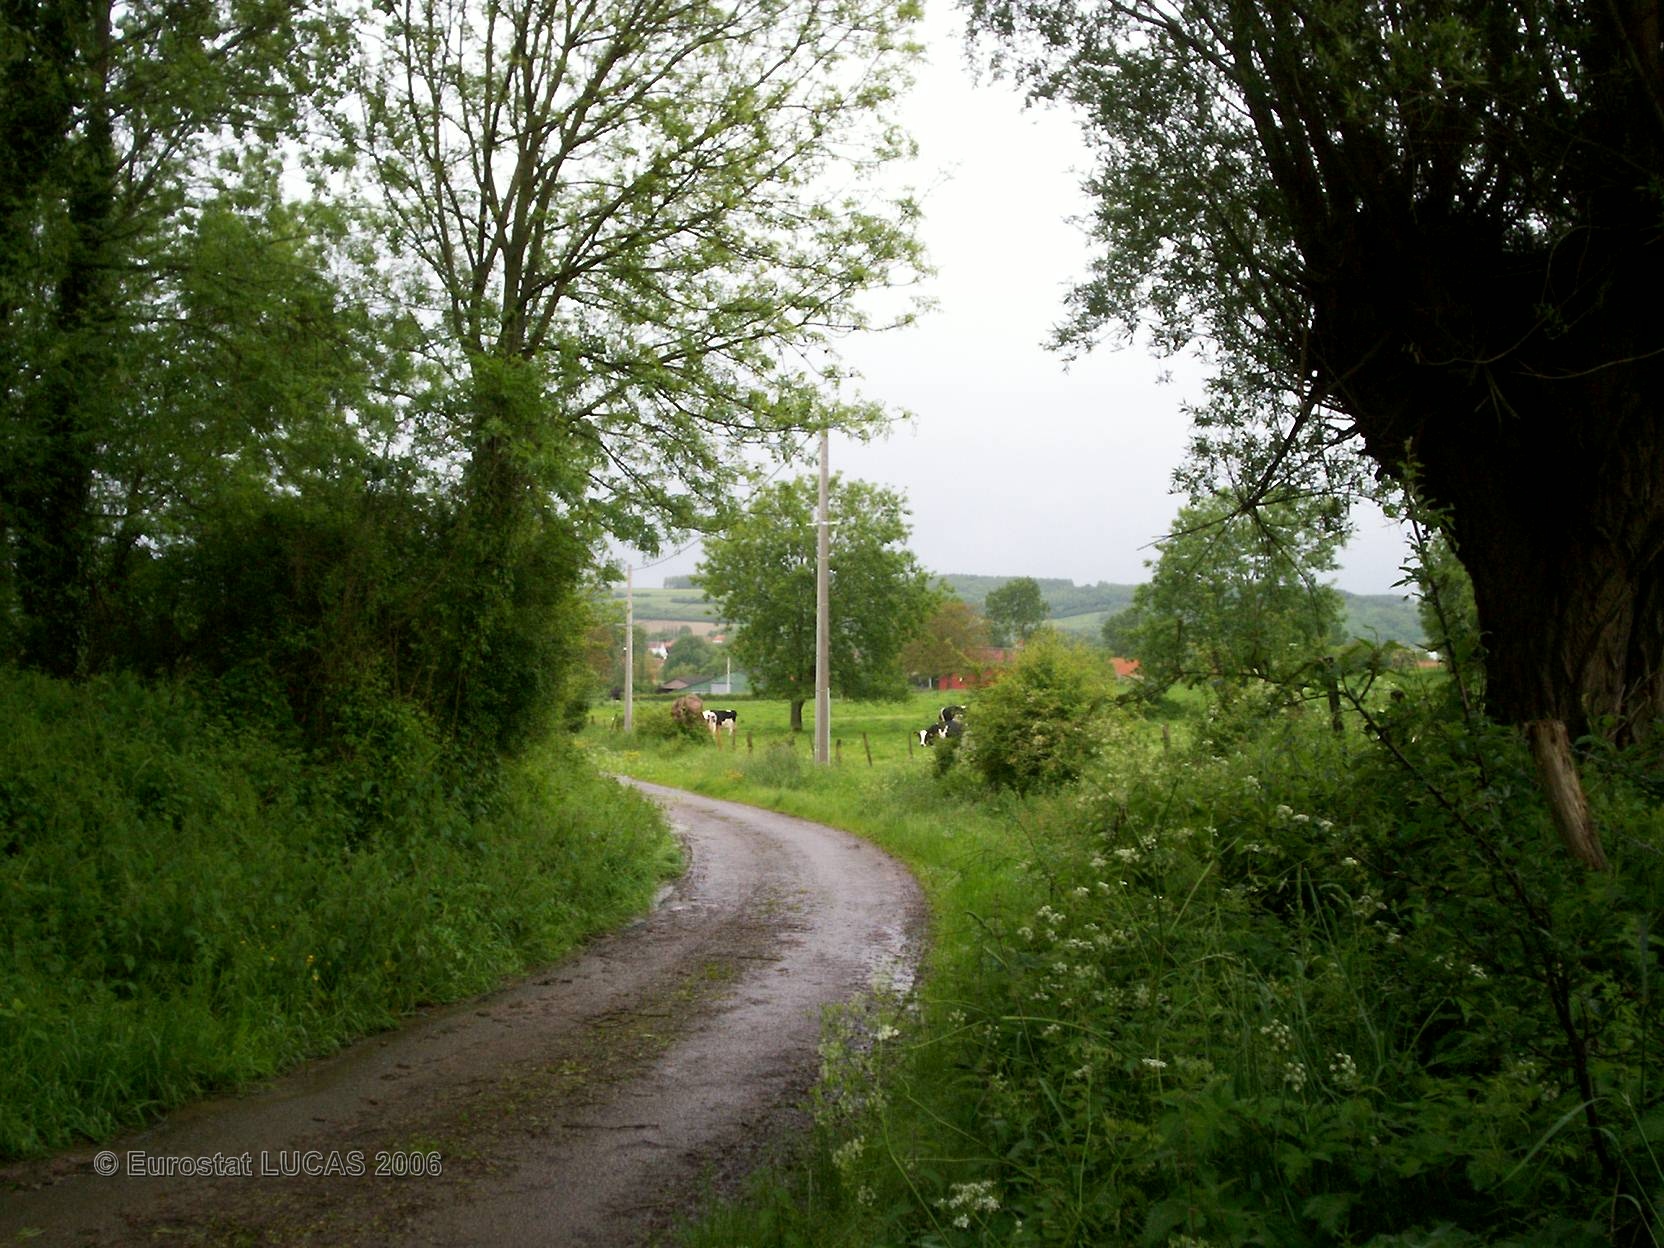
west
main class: Grassland
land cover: Grassland with sparse tree/shrub cover
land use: Agriculture (excluding fallow land and kitchen gardens)
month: May
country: FR
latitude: 50.4255
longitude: 2.5130
